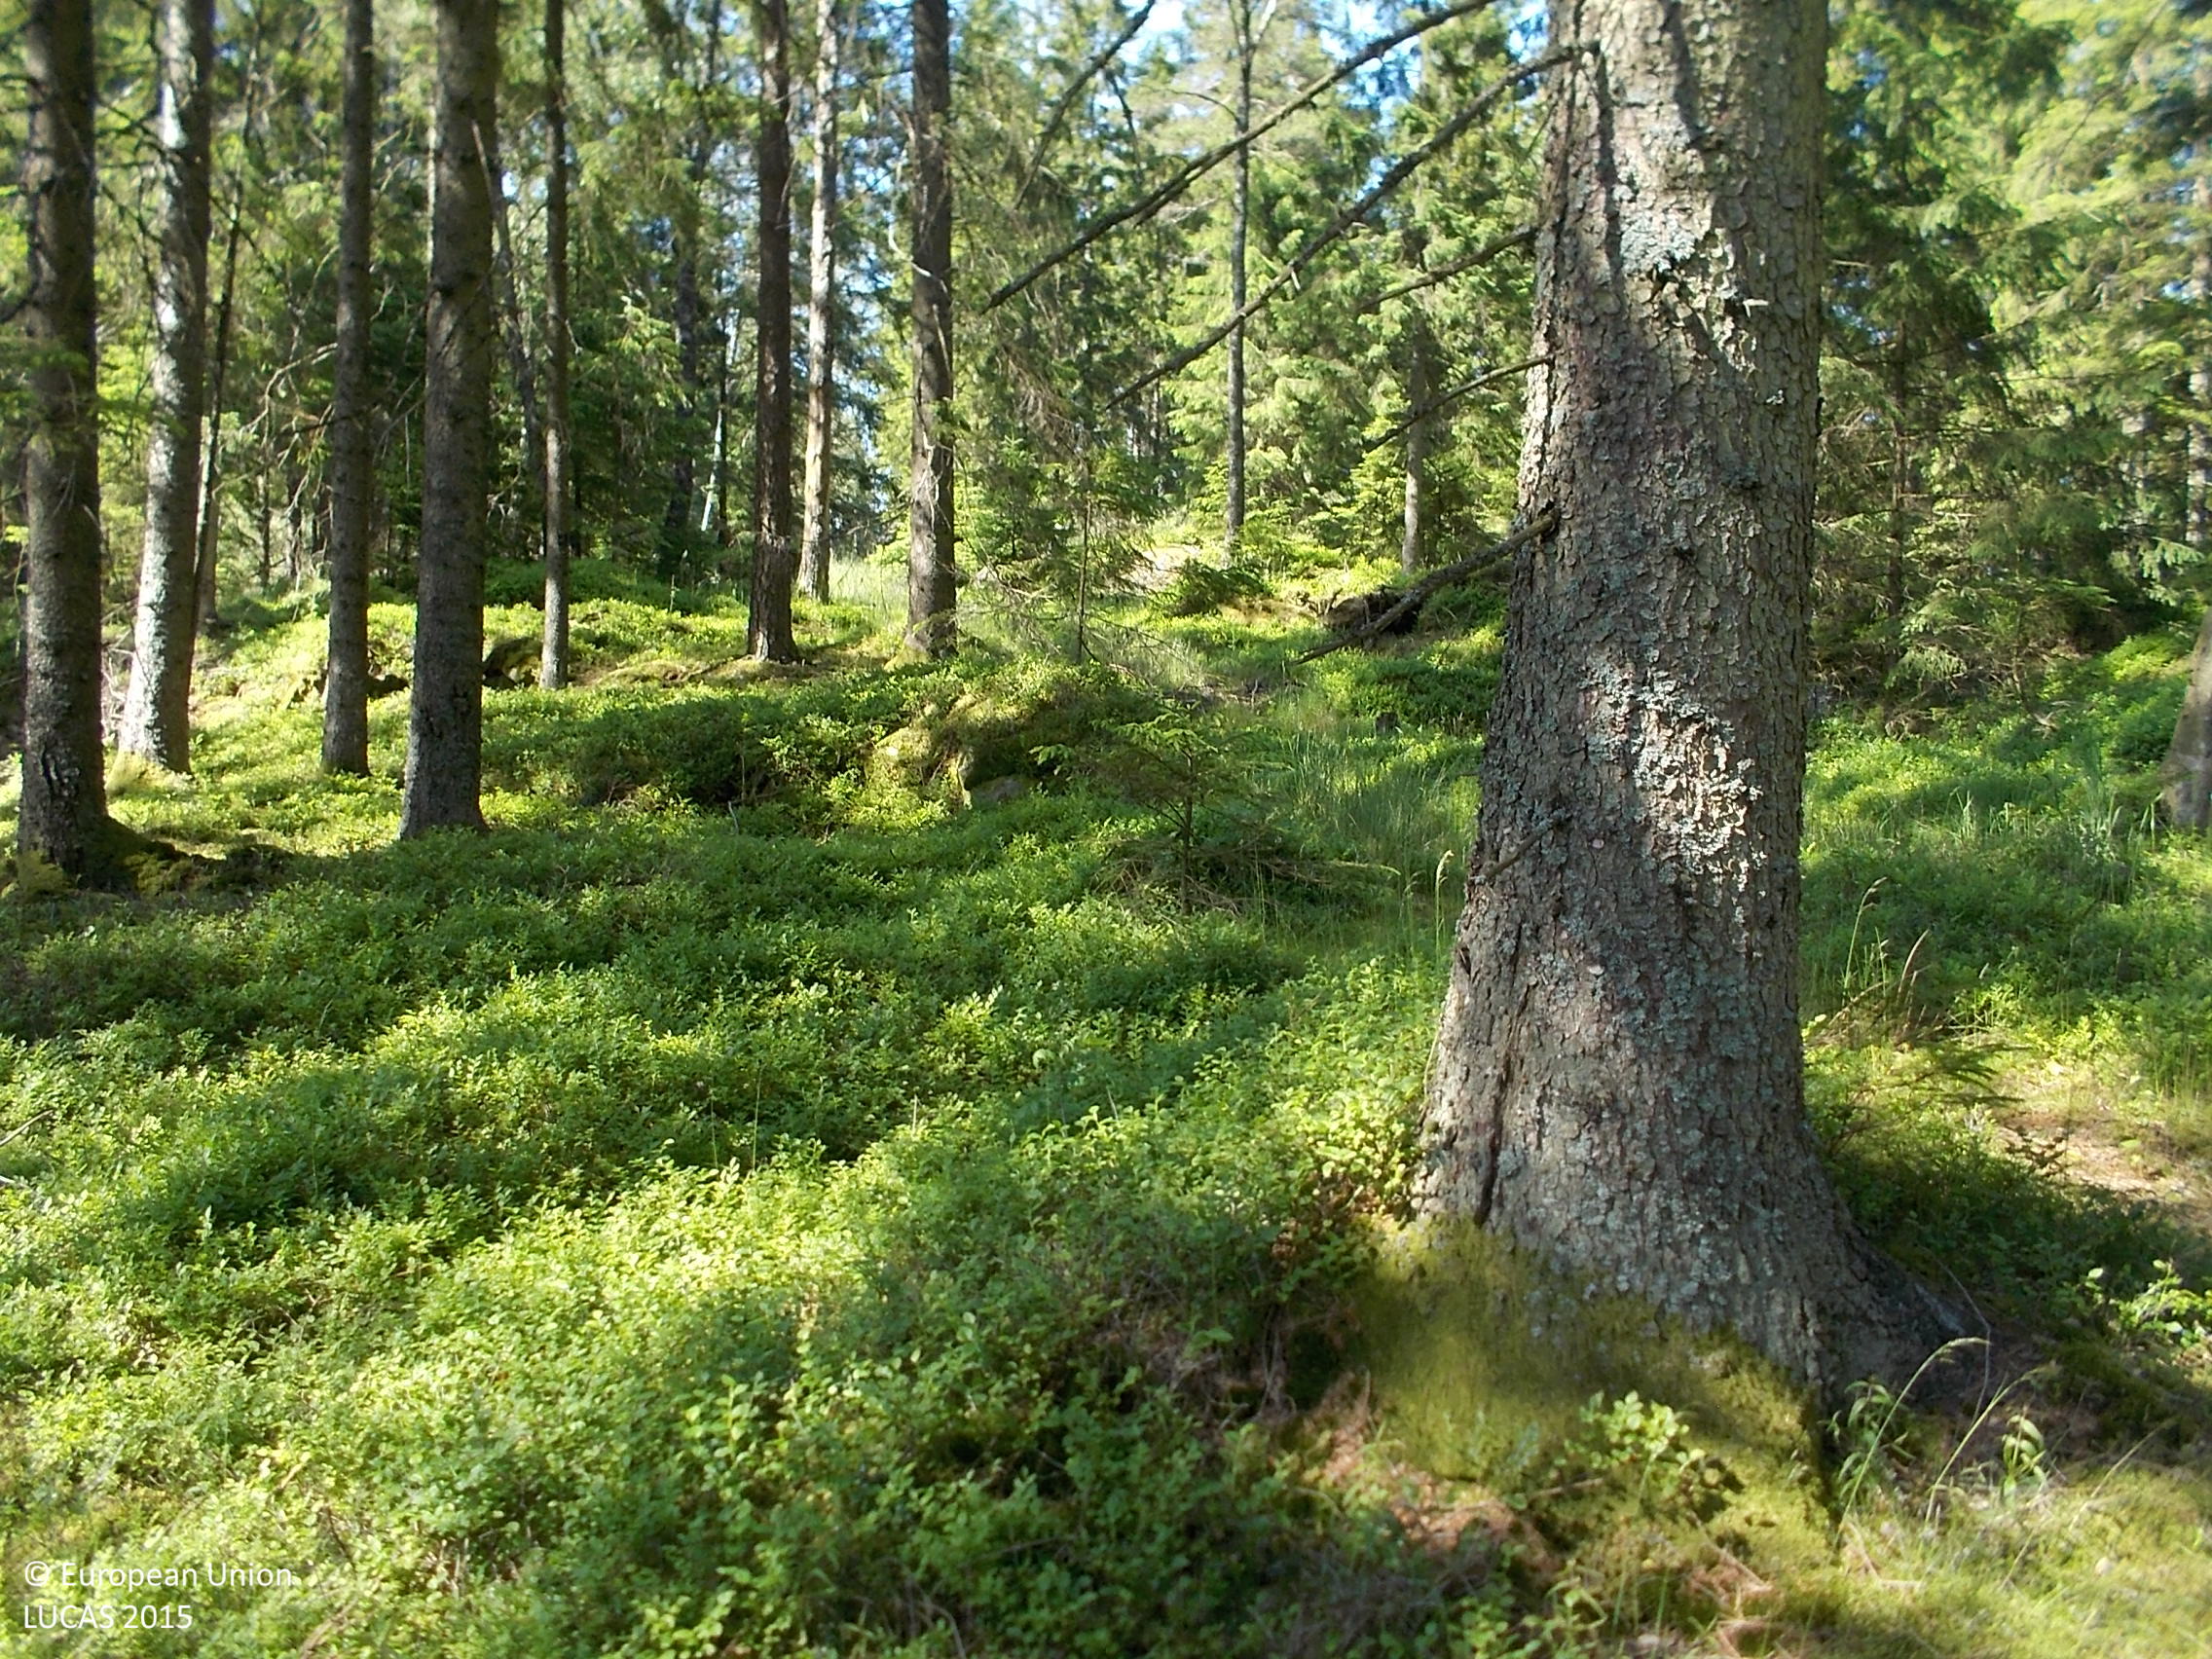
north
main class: Woodland
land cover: Spruce dominated coniferous woodland
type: boreal forest
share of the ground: 50 - 75 %
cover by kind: coniferous forest trees 70 %, shrubs 25 %, herbaceous plants 5 %
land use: Forestry
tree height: > 5 m
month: June
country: SE
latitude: 57.3566
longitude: 13.0710
